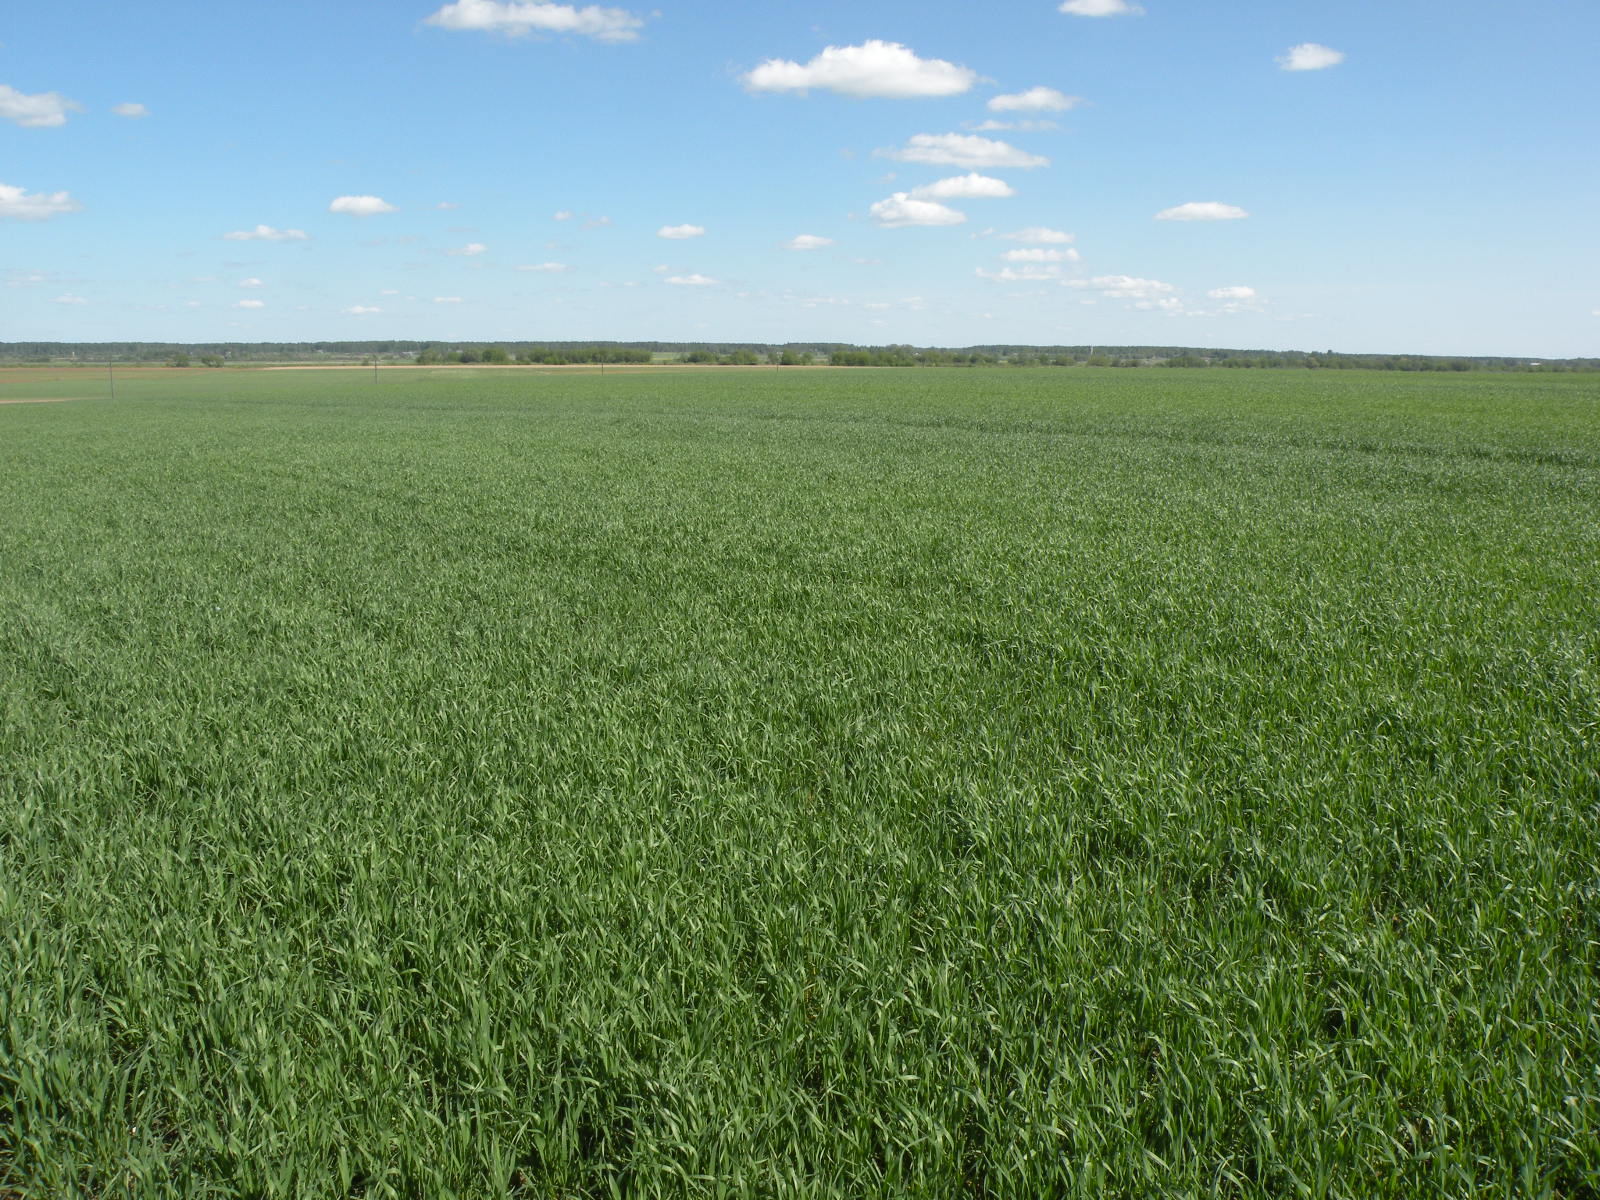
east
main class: Cropland
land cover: Common wheat
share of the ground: > 75 %
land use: Agriculture (excluding fallow land and kitchen gardens)
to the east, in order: Common wheat
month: May
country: LV
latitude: 56.0701
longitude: 26.3209
